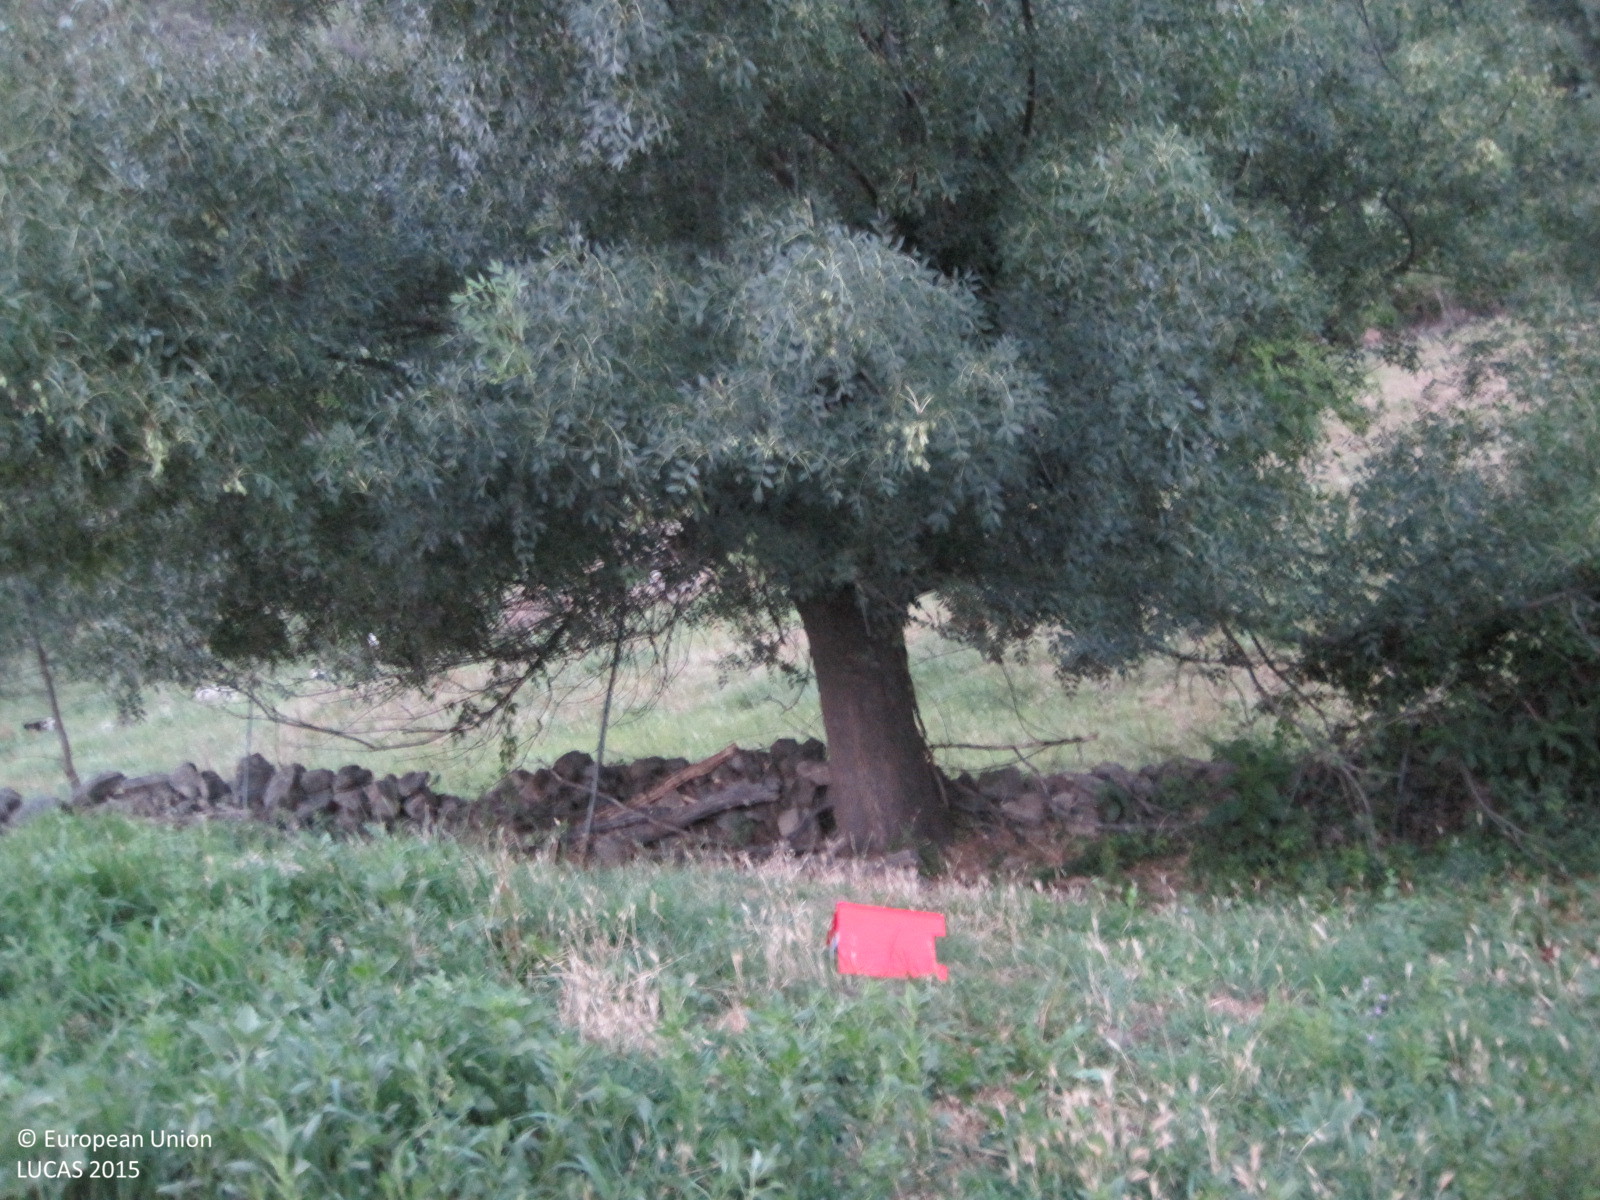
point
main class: Grassland
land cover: Grassland with sparse tree/shrub cover
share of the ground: > 75 %
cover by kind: herbaceous plants 95 %, broadleaved forest trees 5 %
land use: Agriculture (excluding fallow land and kitchen gardens)
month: July
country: ES
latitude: 40.2885
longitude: -4.8386
